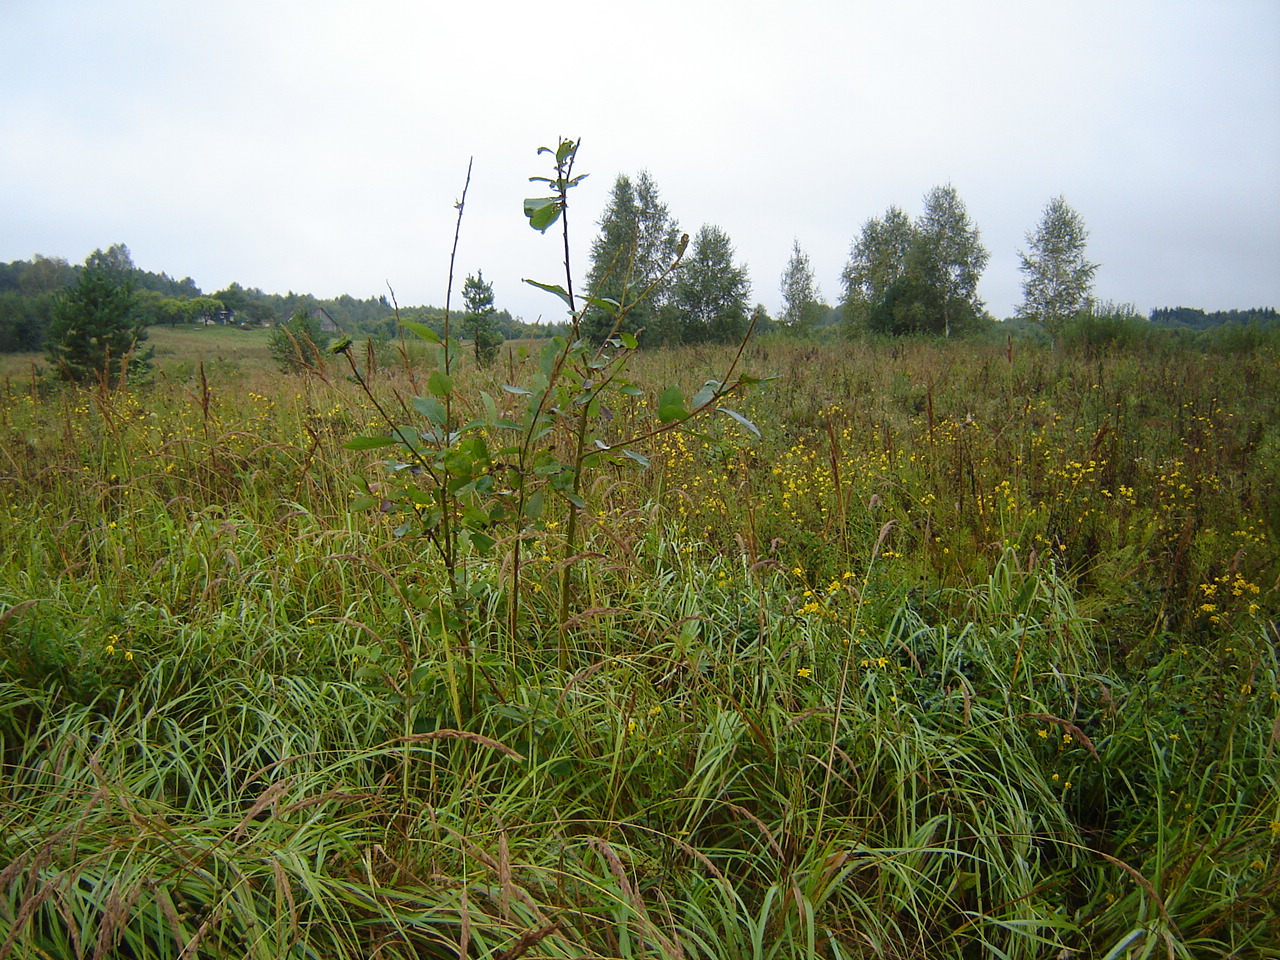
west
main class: Woodland
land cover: Pine dominated mixed woodland
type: hemiboreal forest and nemoral coniferous forest and mixed broadleaved-coniferous forest
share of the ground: 25 - 50 %
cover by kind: herbaceous plants 70 %, broadleaved forest trees 20 %, coniferous forest trees 10 %
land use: Forestry
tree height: < 5 m
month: September
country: LT
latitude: 54.8926
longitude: 25.3234
